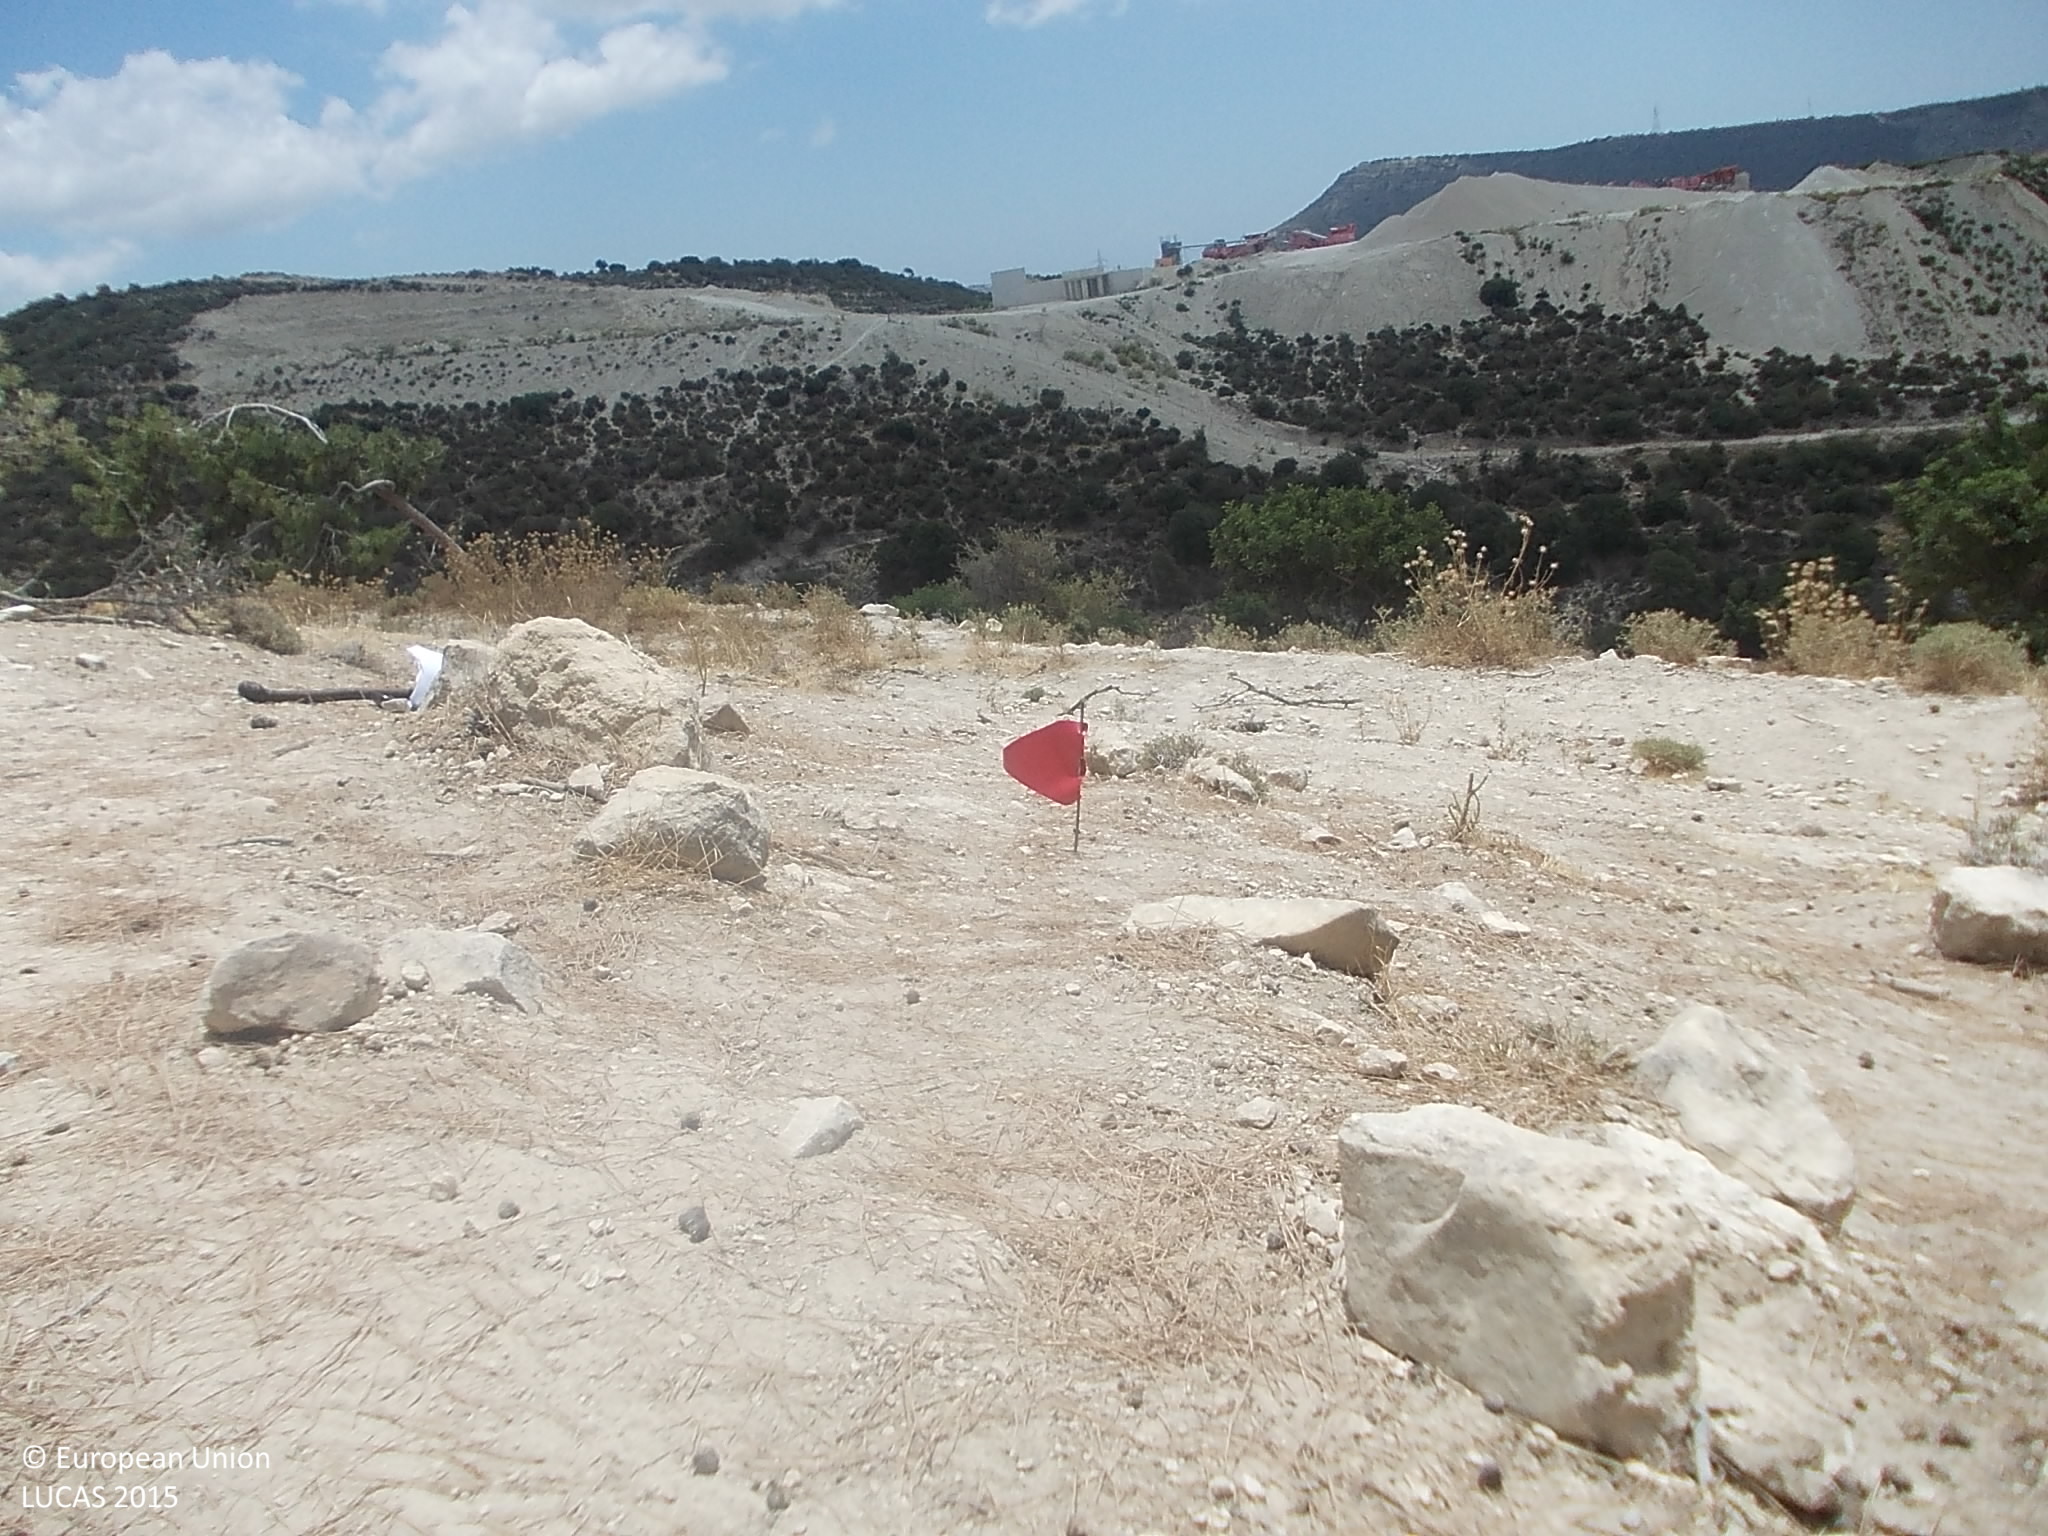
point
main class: Woodland
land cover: Pine dominated coniferous woodland
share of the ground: 25 - 50 %
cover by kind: coniferous forest trees 35 %, unconsolidated bare surface 30 %, consolidated bare surface 25 %, shrubs 5 %, herbaceous plants 5 %
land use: Semi-natural and natural areas not in use
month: June
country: CY
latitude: 34.7758
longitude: 32.9244
